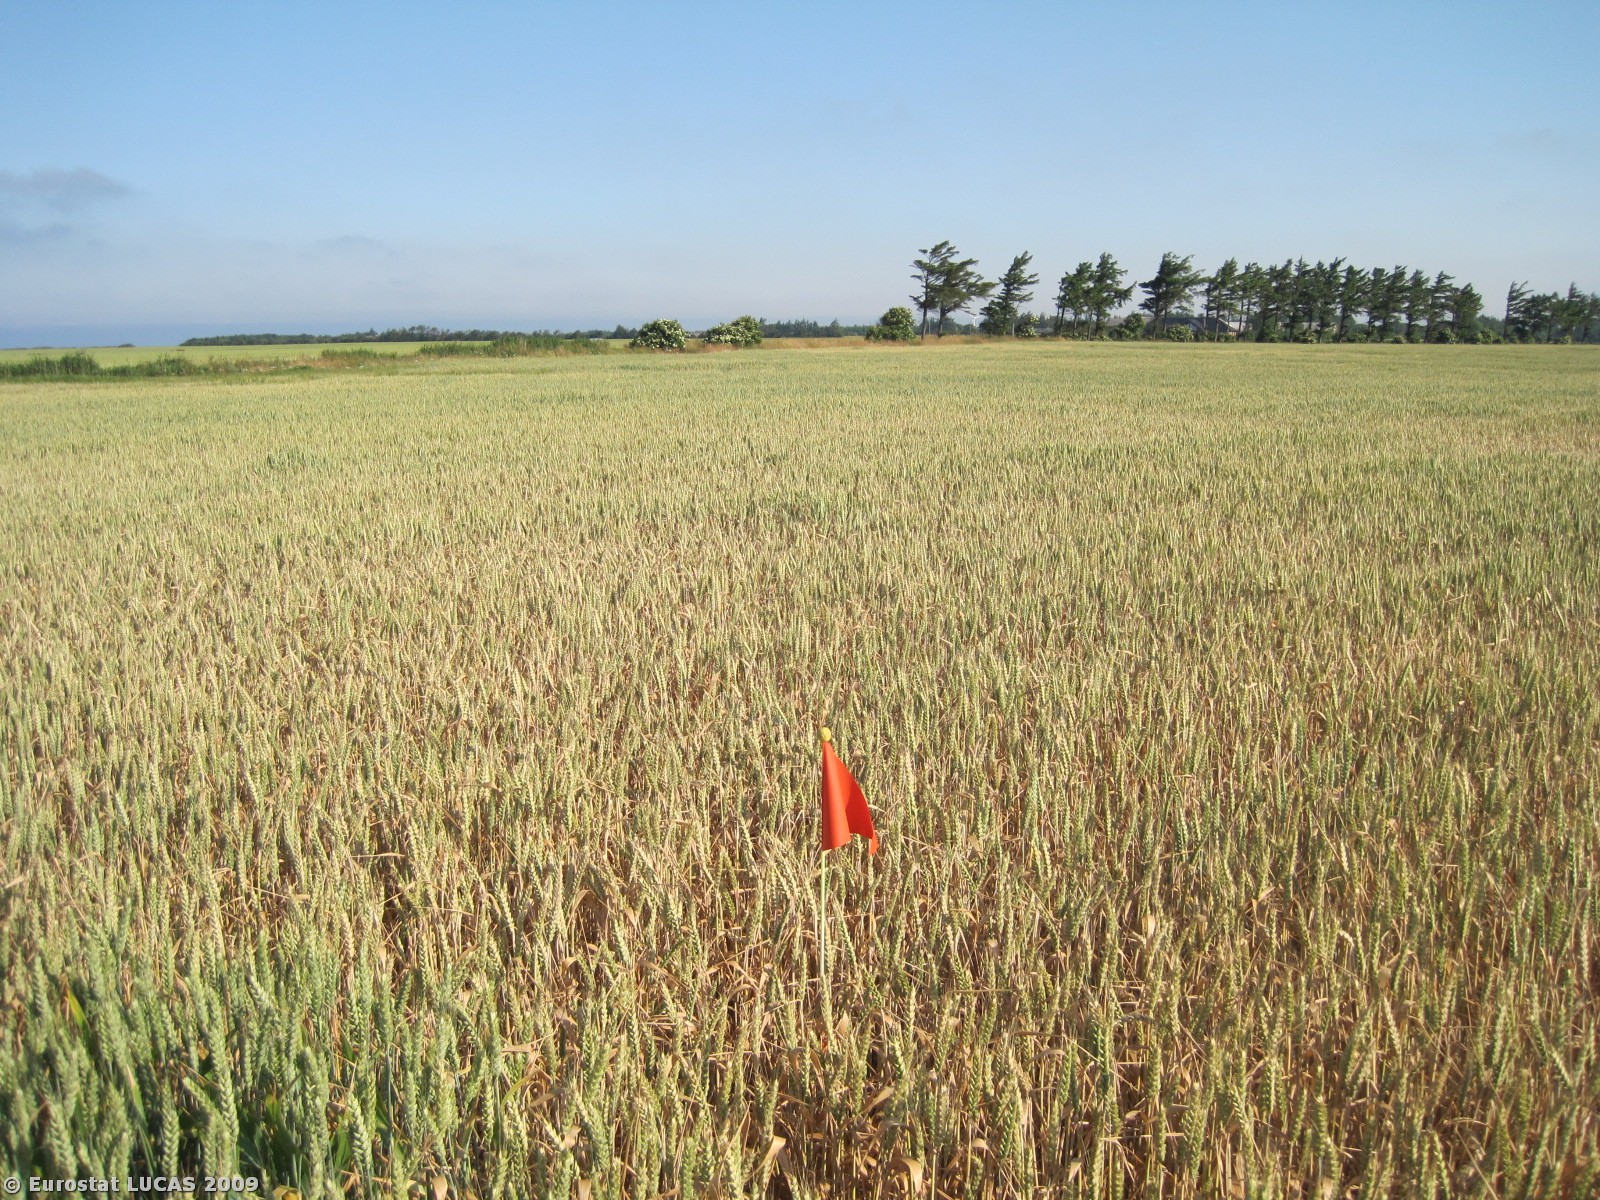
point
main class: Cropland
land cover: Common wheat
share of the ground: > 75 %
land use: Agriculture (excluding fallow land and kitchen gardens)
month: July
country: DK
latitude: 56.3730
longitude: 8.2048
